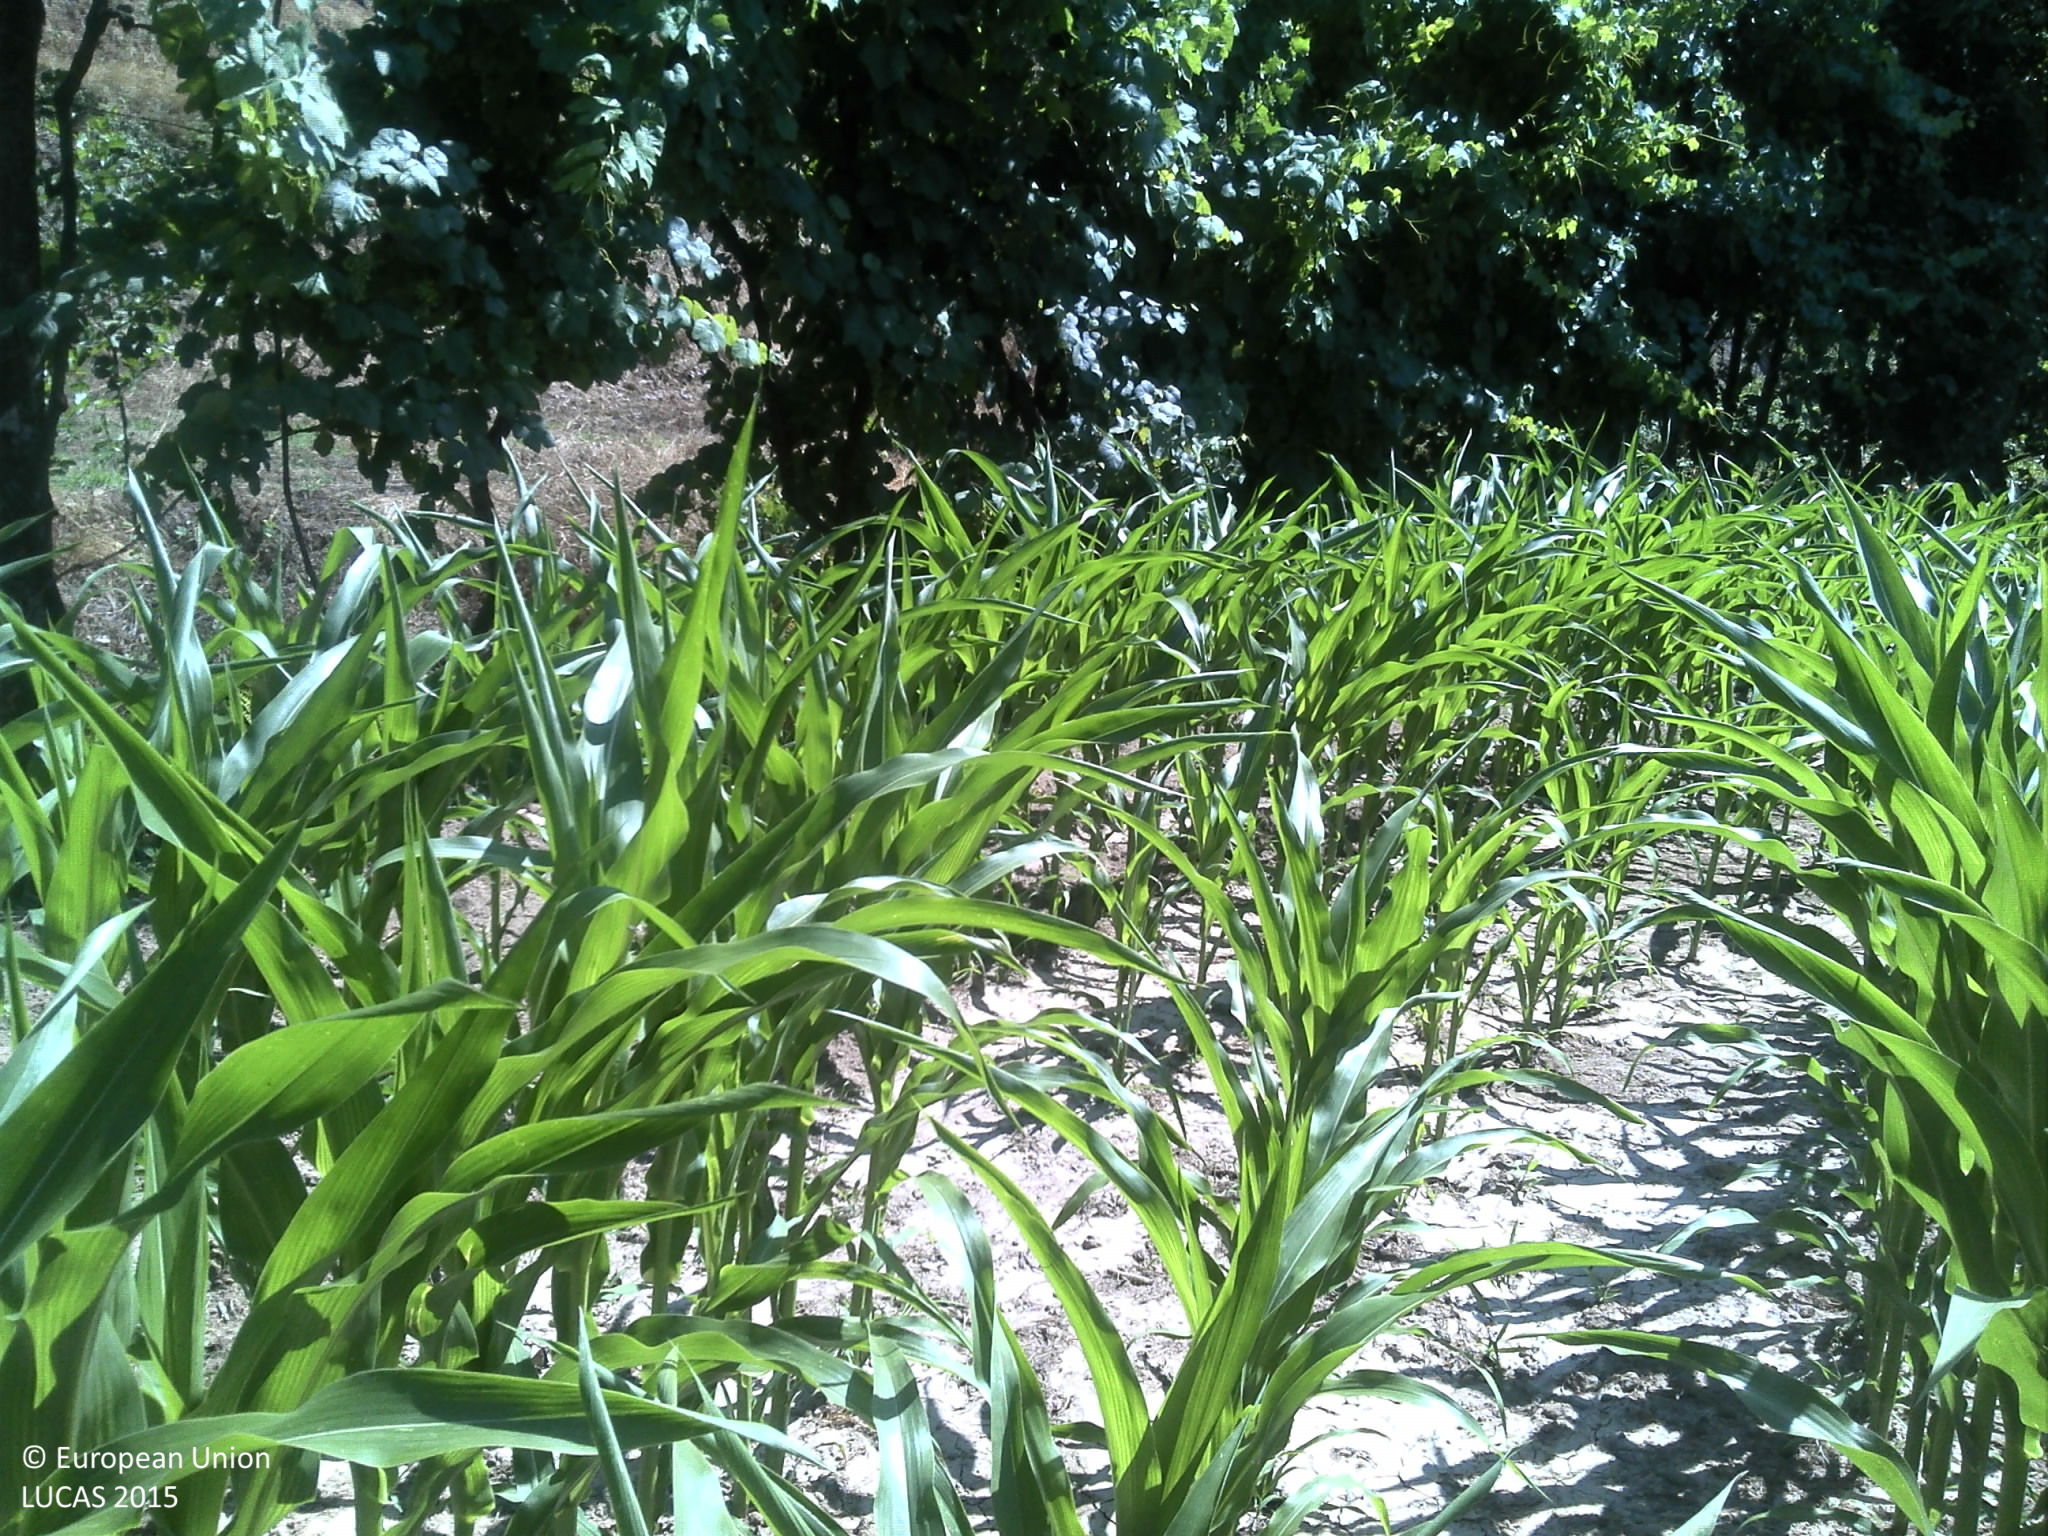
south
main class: Cropland
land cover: Maize
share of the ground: > 75 %
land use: Agriculture (excluding fallow land and kitchen gardens)
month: June
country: PT
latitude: 41.4481
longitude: -8.0114
